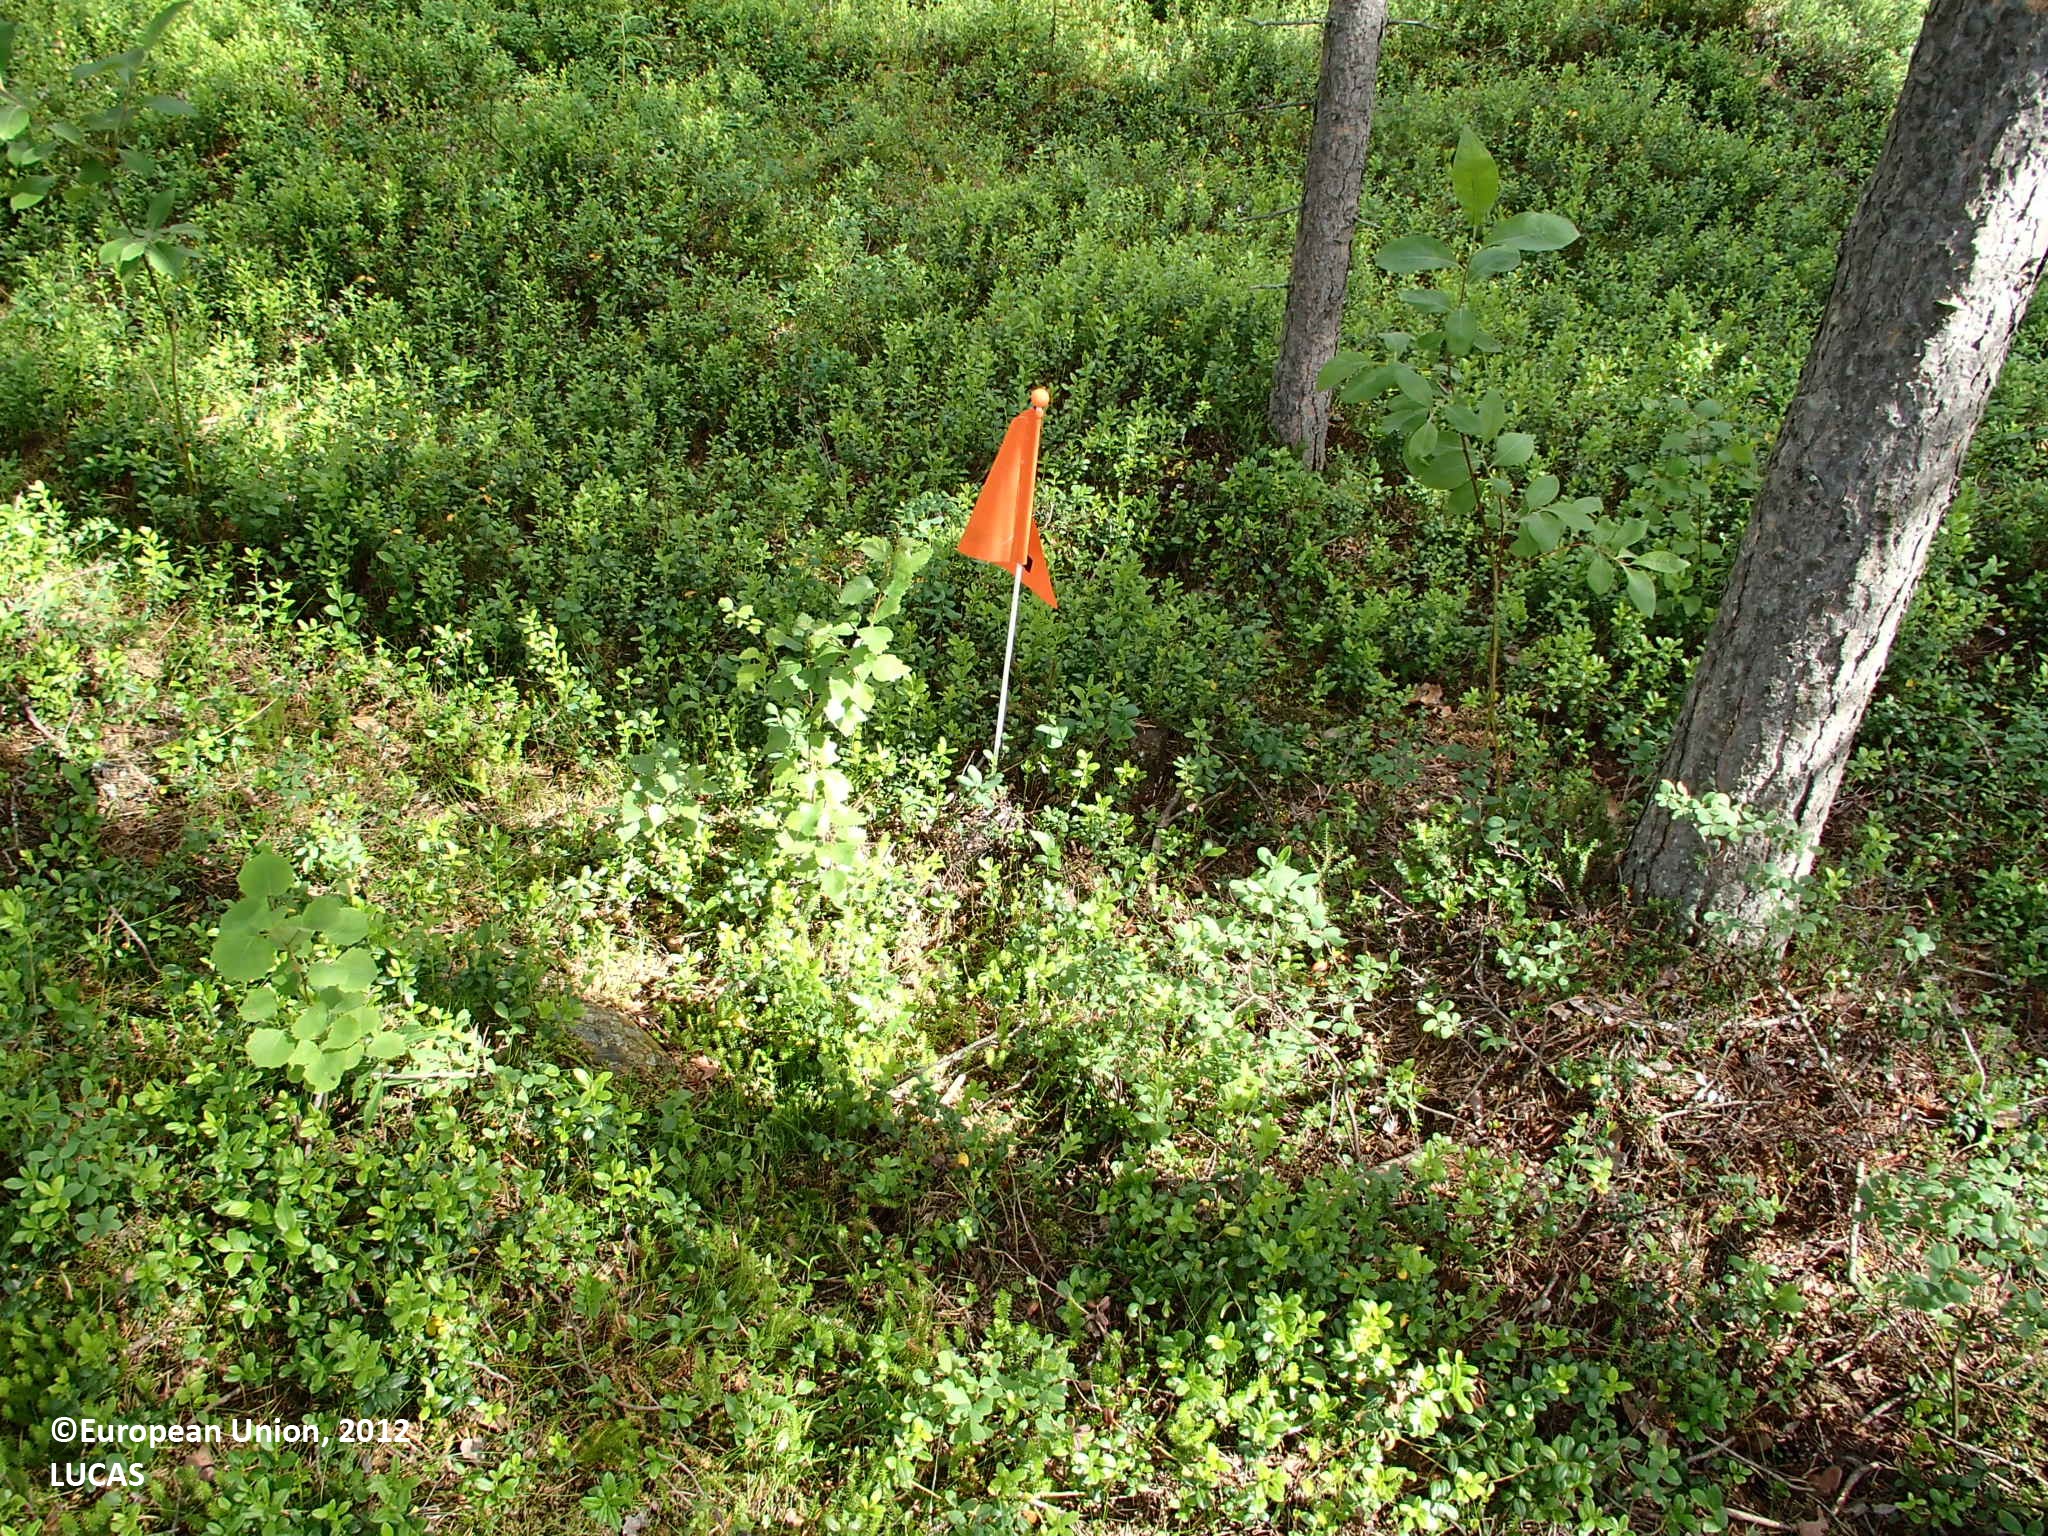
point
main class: Woodland
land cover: Pine dominated coniferous woodland
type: boreal forest
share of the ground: > 75 %
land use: Forestry
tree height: > 5 m
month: July
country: FI
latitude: 67.2762
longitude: 25.5262
